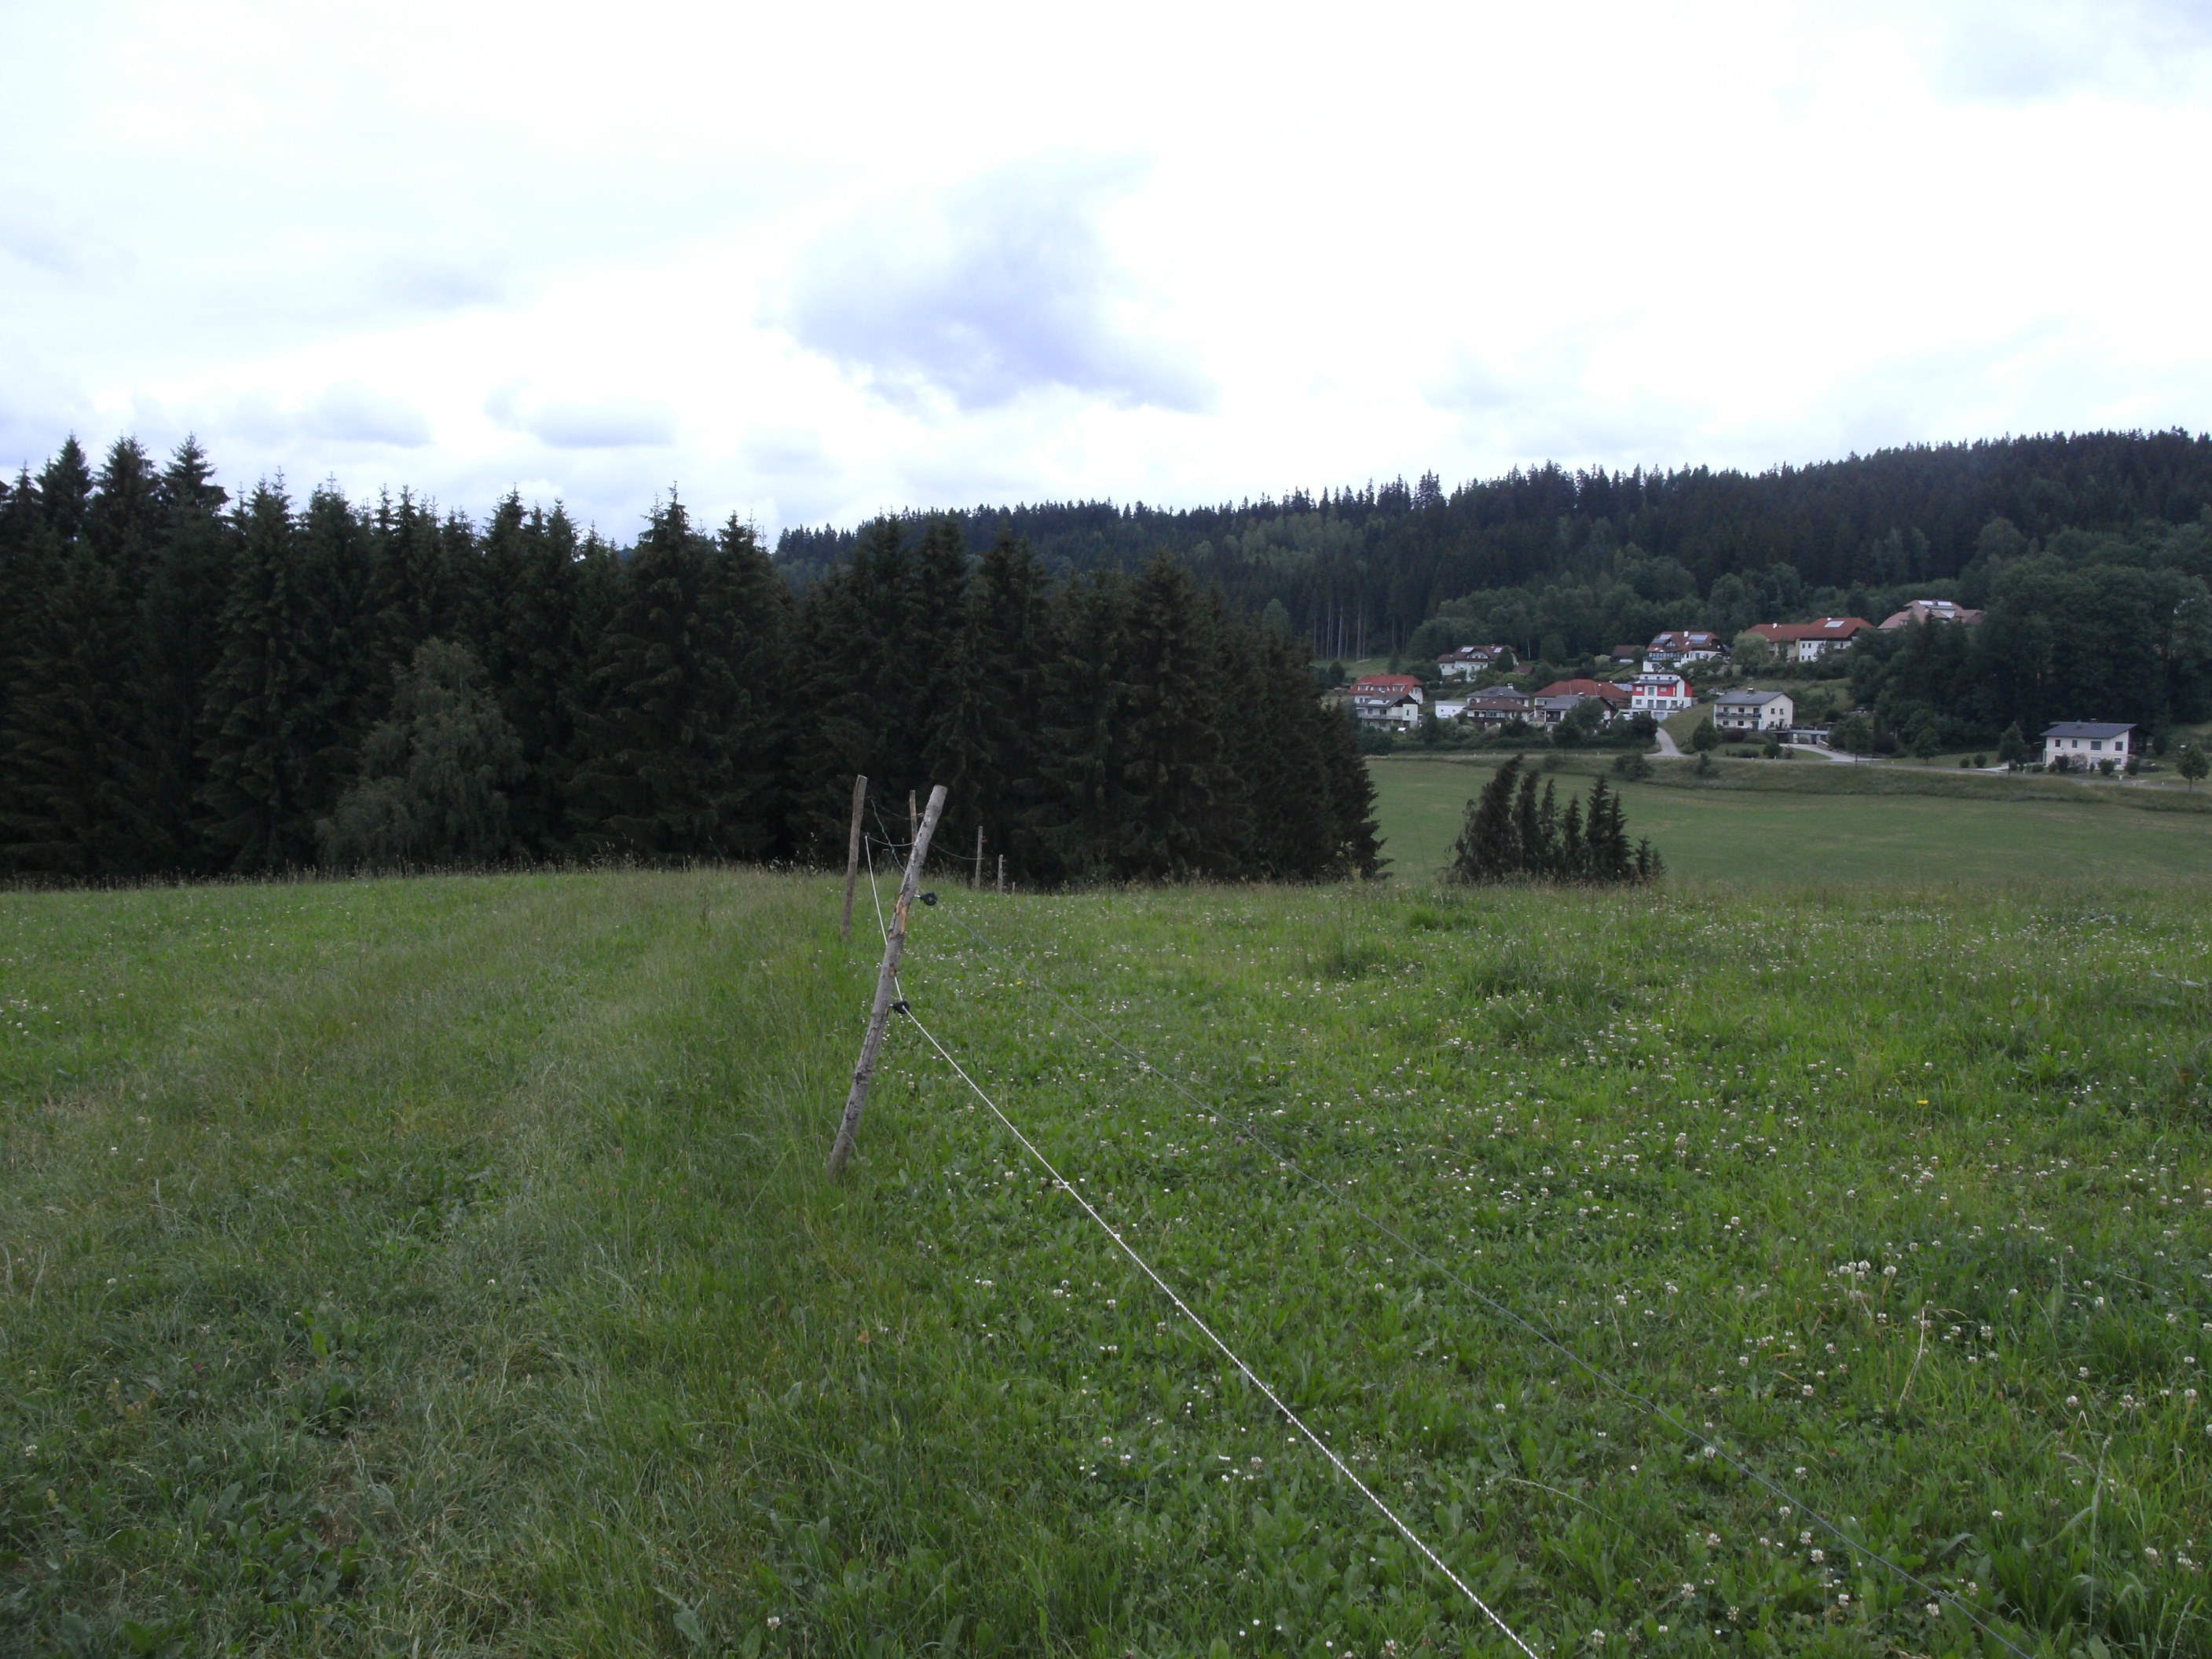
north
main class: Grassland
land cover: Grassland without tree/shrub cover
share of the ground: > 75 %
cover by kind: herbaceous plants 100 %
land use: Agriculture (excluding fallow land and kitchen gardens)
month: June
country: AT
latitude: 48.4886
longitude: 14.1270
